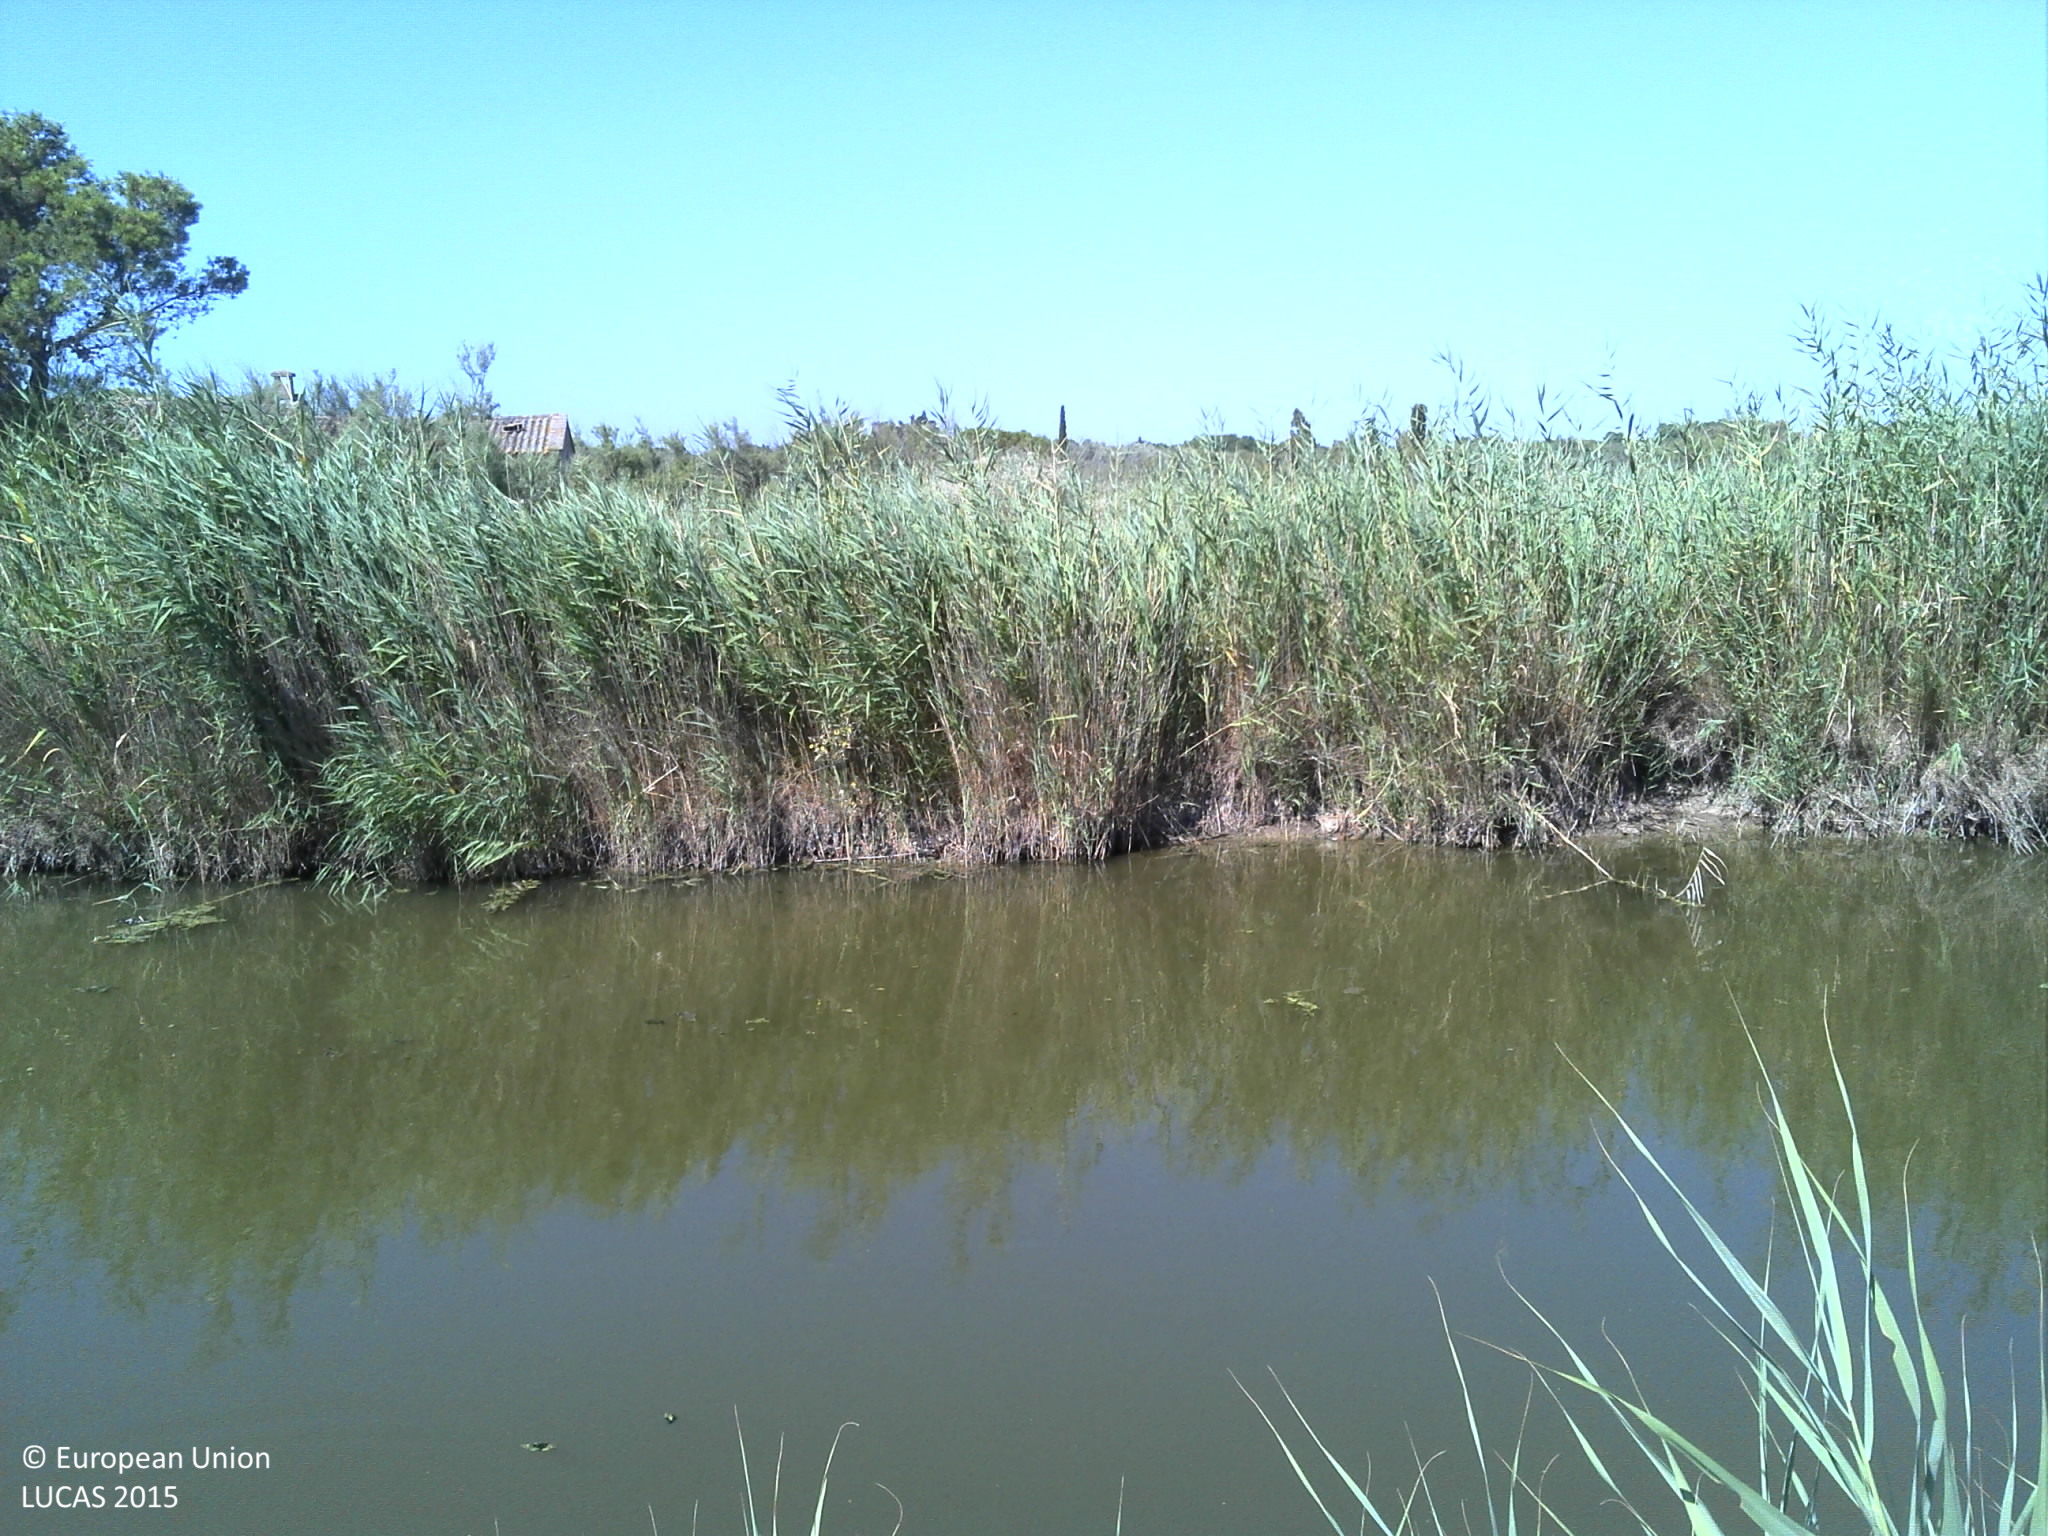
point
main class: Grassland
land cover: Spontaneously vegetated surfaces
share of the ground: > 75 %
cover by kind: herbaceous plants 100 %
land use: Semi-natural and natural areas not in use
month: July
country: FR
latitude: 43.5997
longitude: 4.0260
